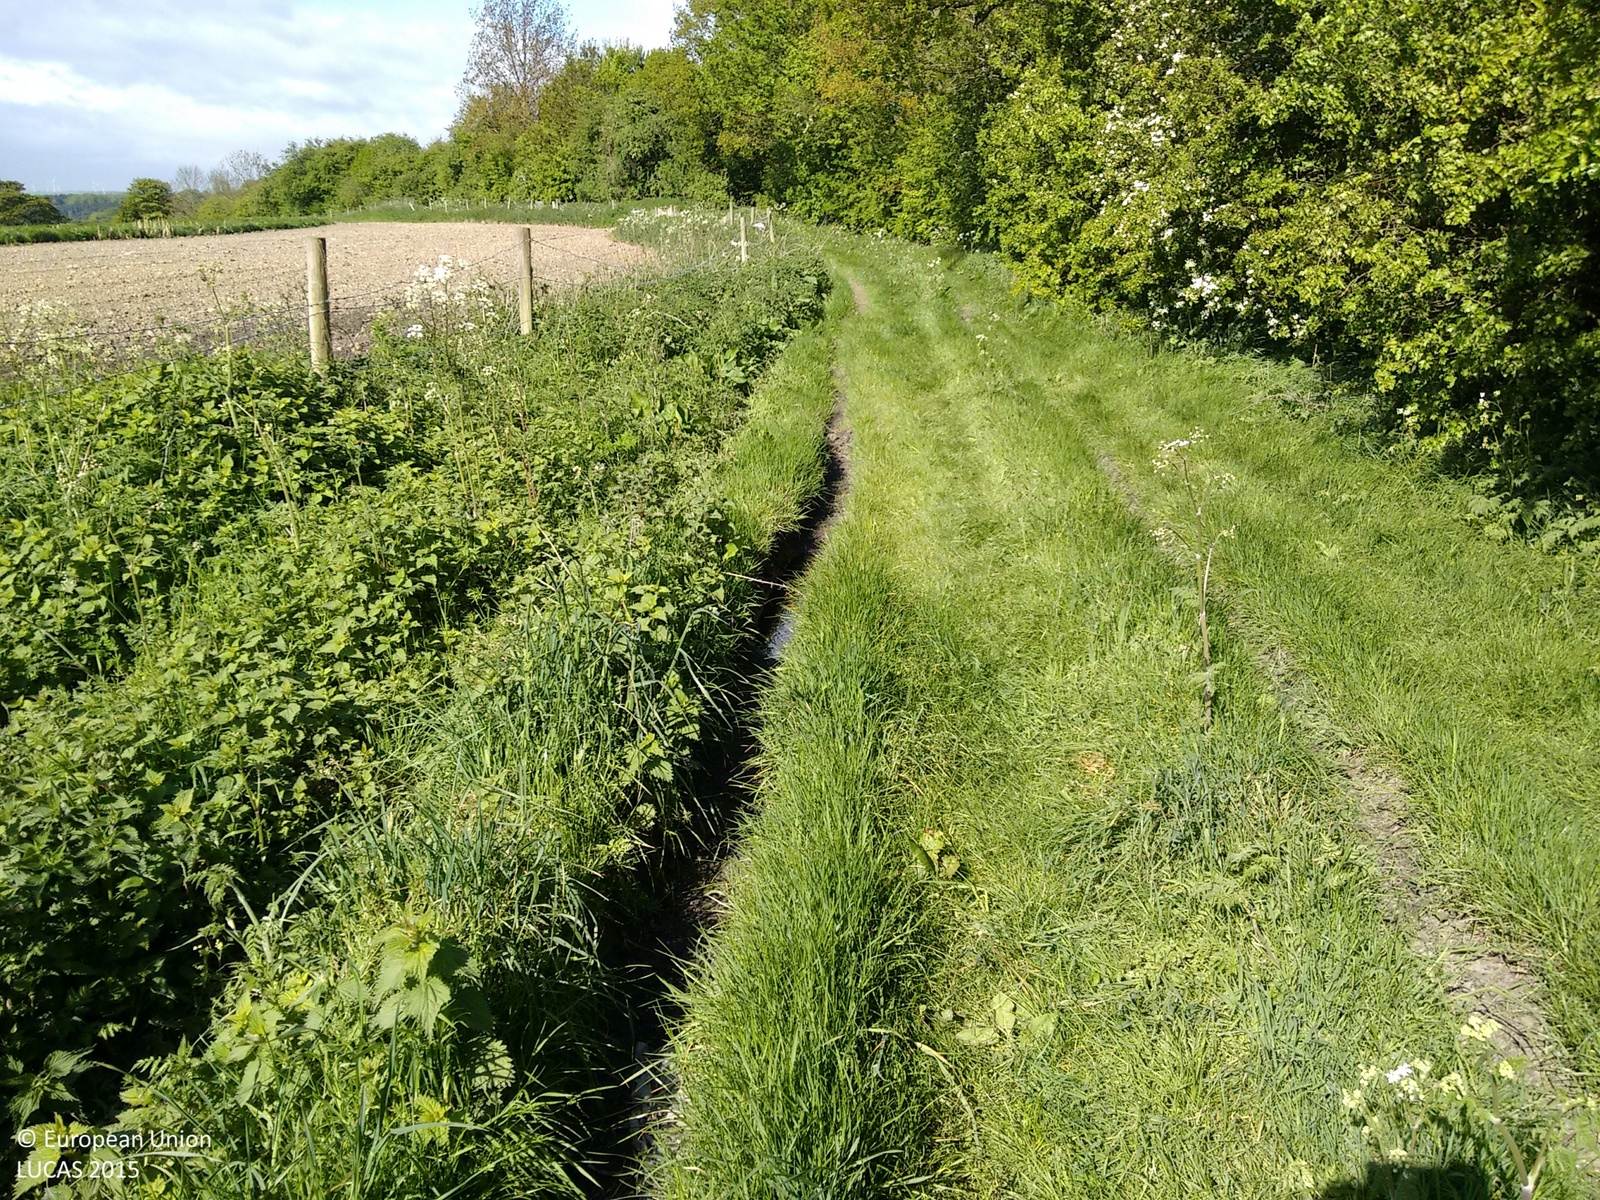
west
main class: Grassland
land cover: Grassland without tree/shrub cover
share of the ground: > 75 %
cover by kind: herbaceous plants 100 %
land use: Agriculture (excluding fallow land and kitchen gardens)
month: May
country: GB
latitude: 53.5894
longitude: -1.5779
